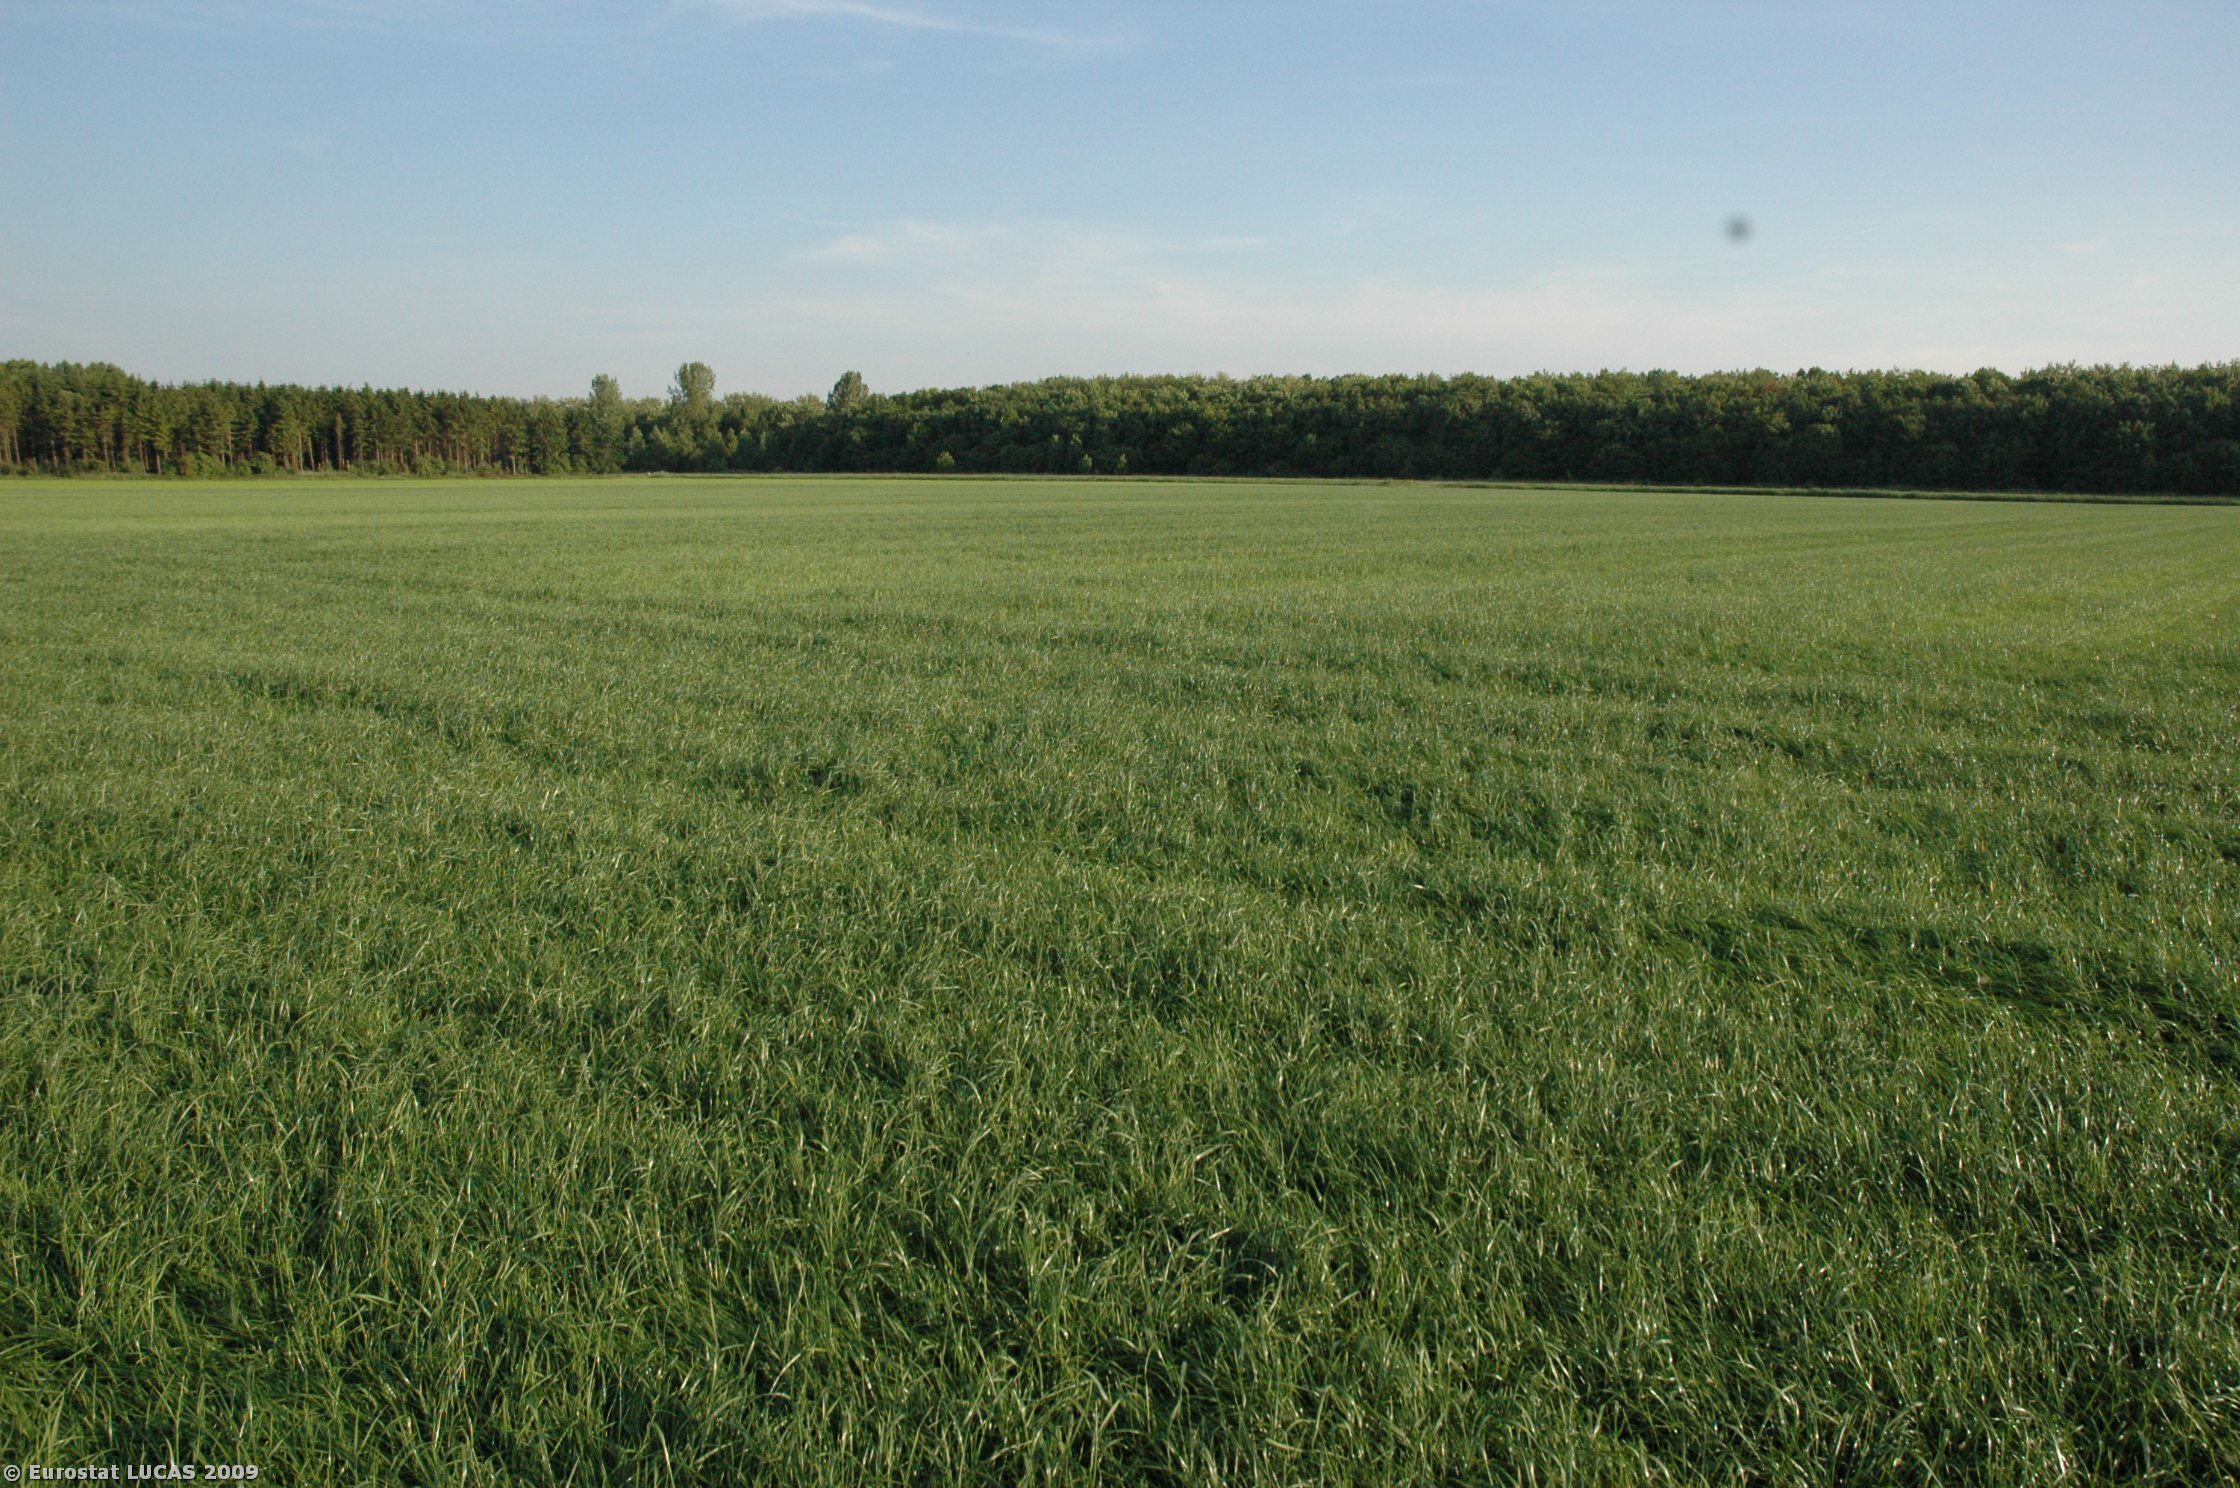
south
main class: Grassland
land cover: Grassland without tree/shrub cover
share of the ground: > 75 %
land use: Agriculture (excluding fallow land and kitchen gardens)
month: June
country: NL
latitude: 52.2708
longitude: 5.4113
